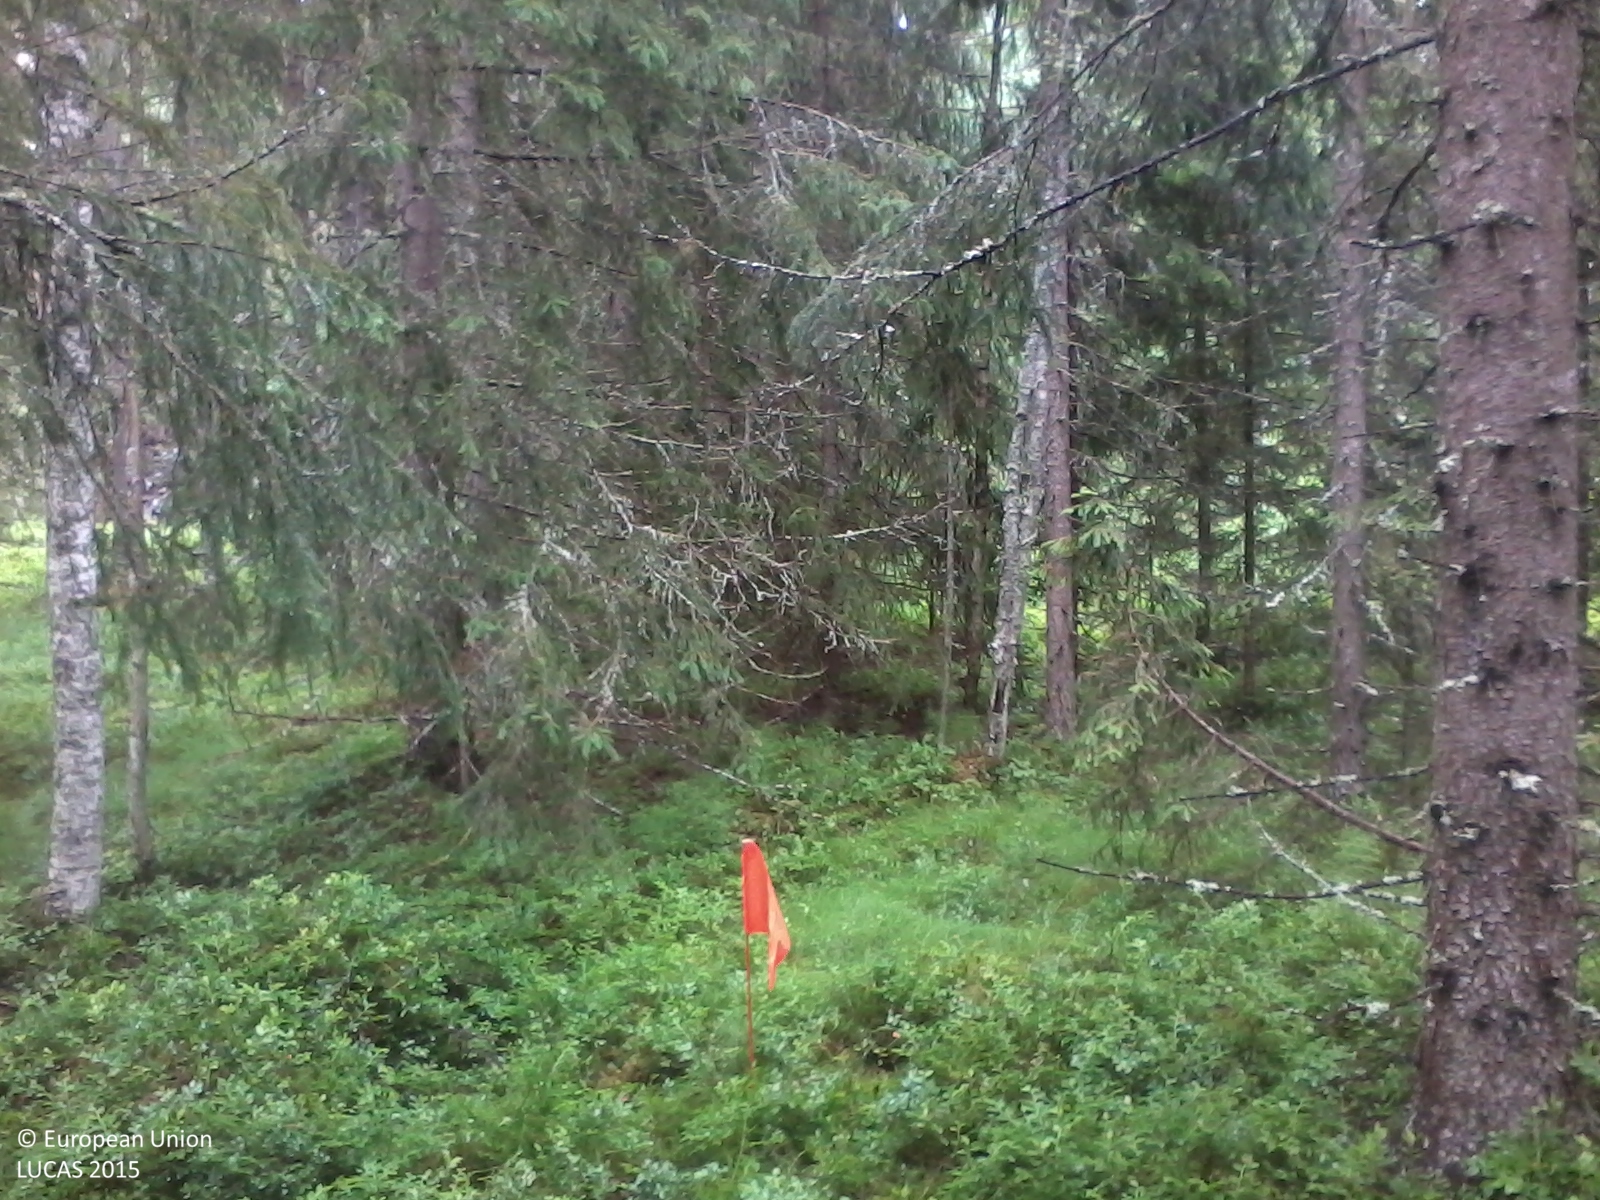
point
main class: Woodland
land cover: Spruce dominated mixed woodland
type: boreal forest
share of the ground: > 75 %
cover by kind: coniferous forest trees 60 %, broadleaved forest trees 20 %, shrubs 15 %, lichens and mosses 5 %
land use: Forestry
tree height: > 5 m
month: July
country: SE
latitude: 63.6316
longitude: 17.2985
